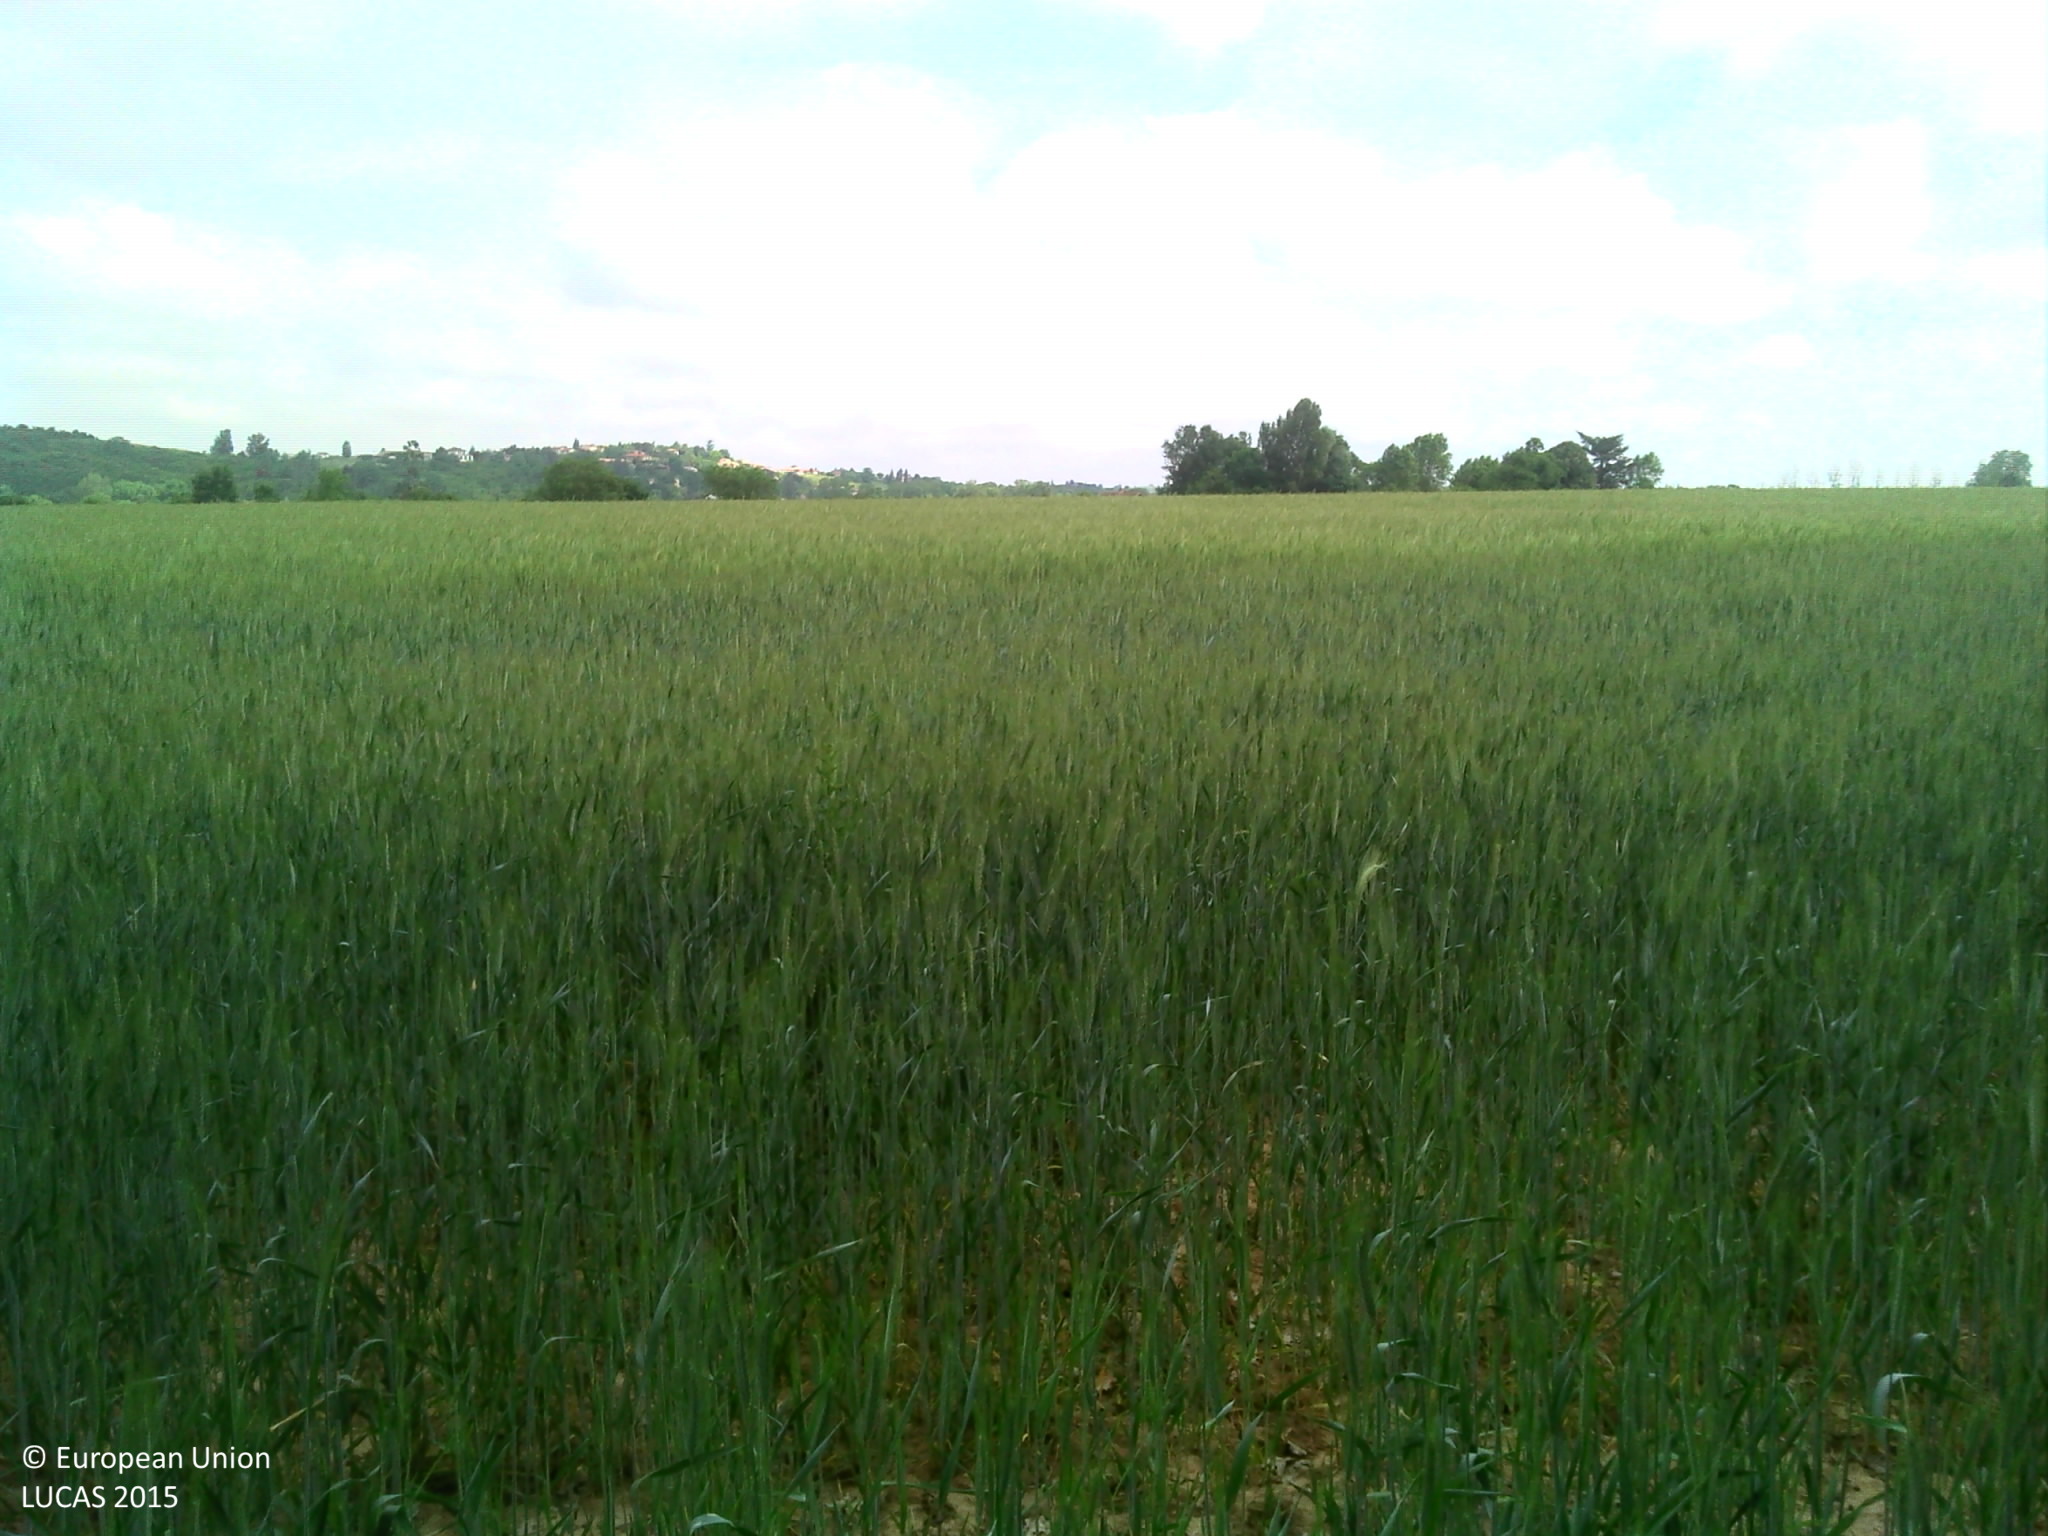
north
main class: Cropland
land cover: Triticale
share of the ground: > 75 %
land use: Agriculture (excluding fallow land and kitchen gardens)
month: May
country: FR
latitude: 43.8011
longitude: 1.7123
